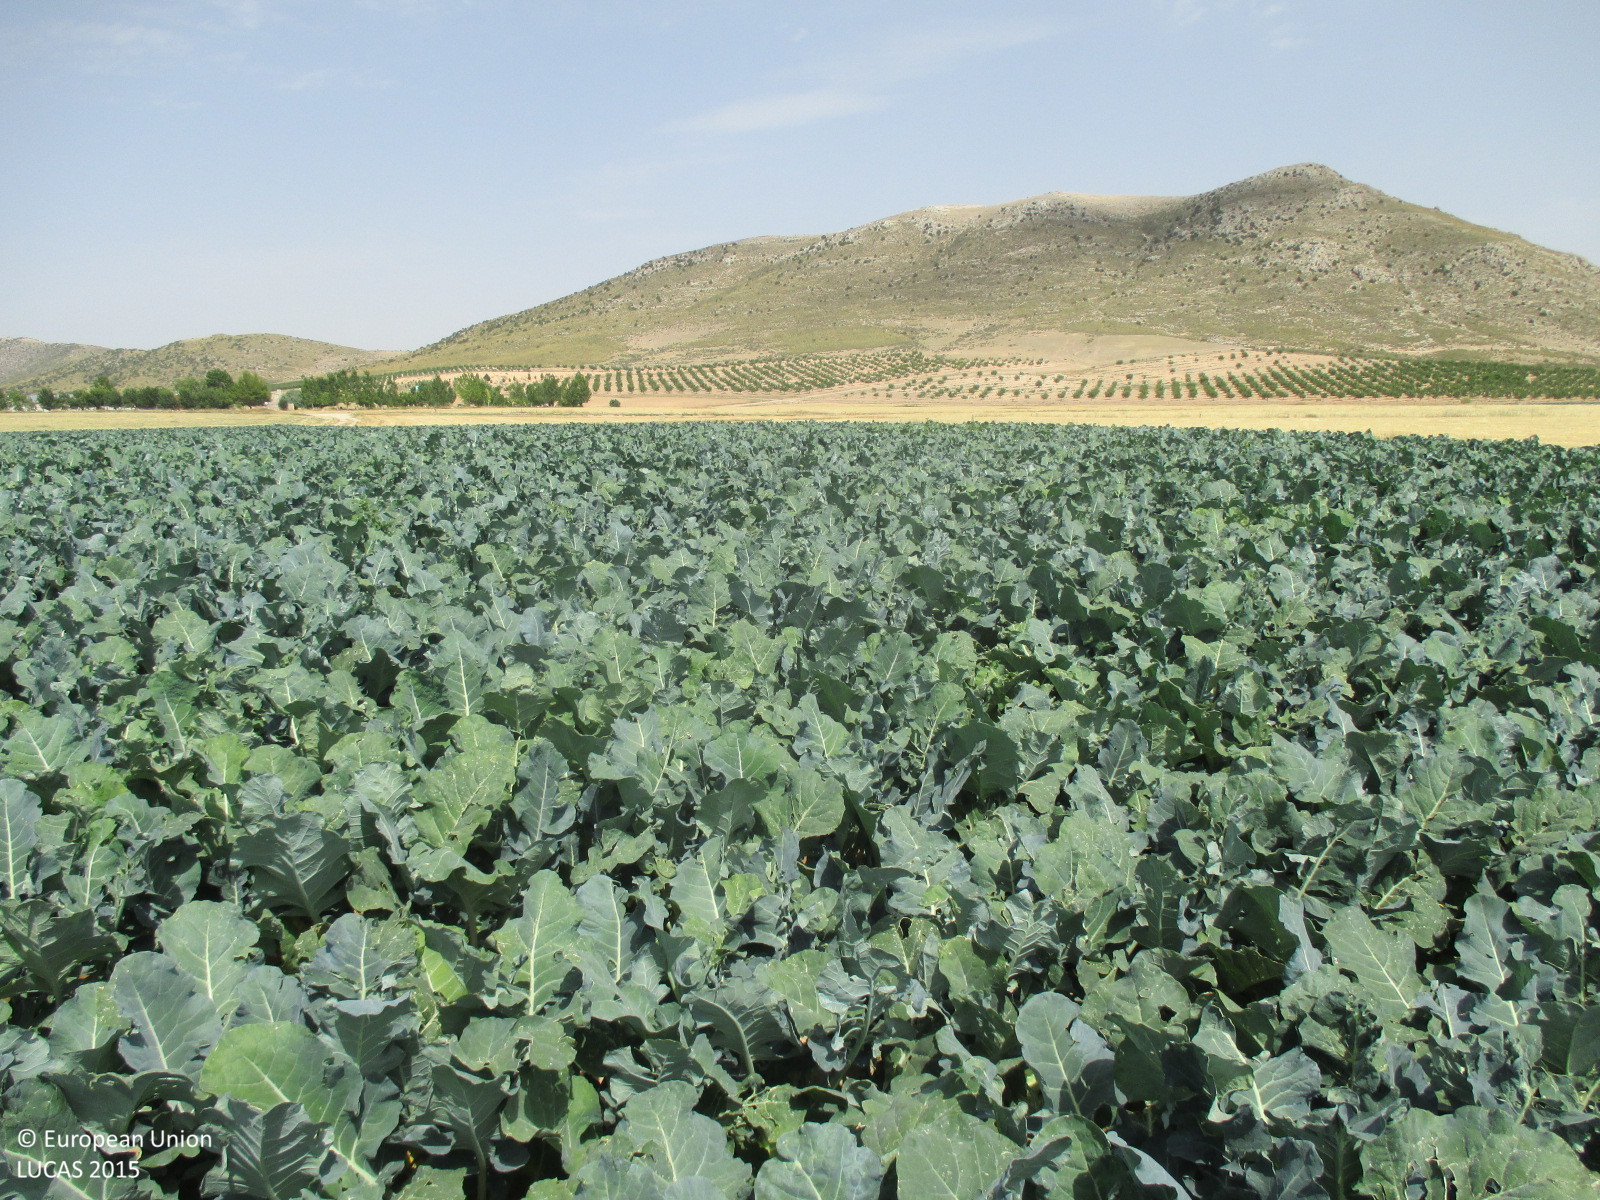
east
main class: Cropland
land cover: Other fresh vegetables
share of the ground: > 75 %
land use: Agriculture (excluding fallow land and kitchen gardens)
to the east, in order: Other fresh vegetables; Grass margins; Tracks; Grass margins; Barley; Grass margins; Spontaneously vegetated surfaces; Grass margins; Paved roads, cycling and walking lanes; Grass margins; Barley
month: July
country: ES
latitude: 37.9039
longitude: -2.3982
